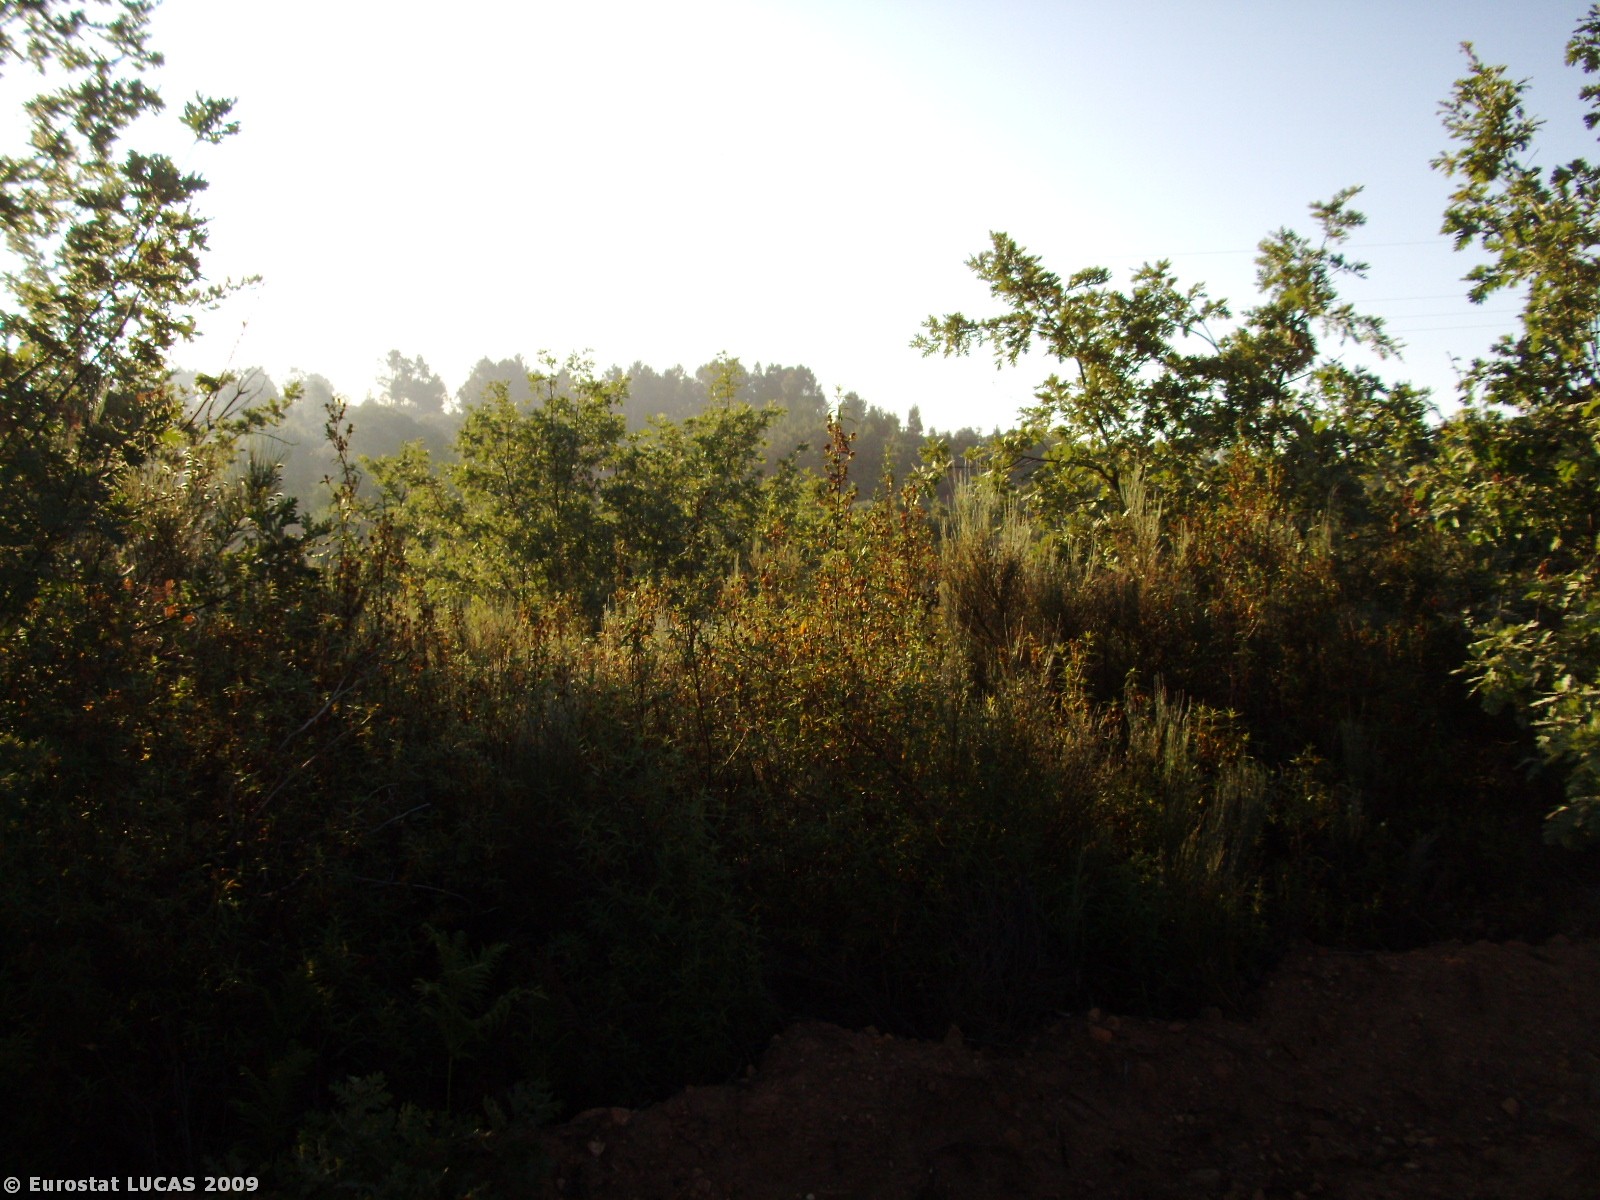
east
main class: Woodland
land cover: Mixed woodland
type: coniferous forest of the mediterranean region
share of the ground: 25 - 50 %
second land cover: Shrubland with sparse tree cover
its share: 50 - 75 %
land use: Forestry
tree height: > 5 m
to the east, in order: Mixed woodland; Shrubland with sparse tree cover; Mixed woodland
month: July
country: PT
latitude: 40.2113
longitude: -7.5073
